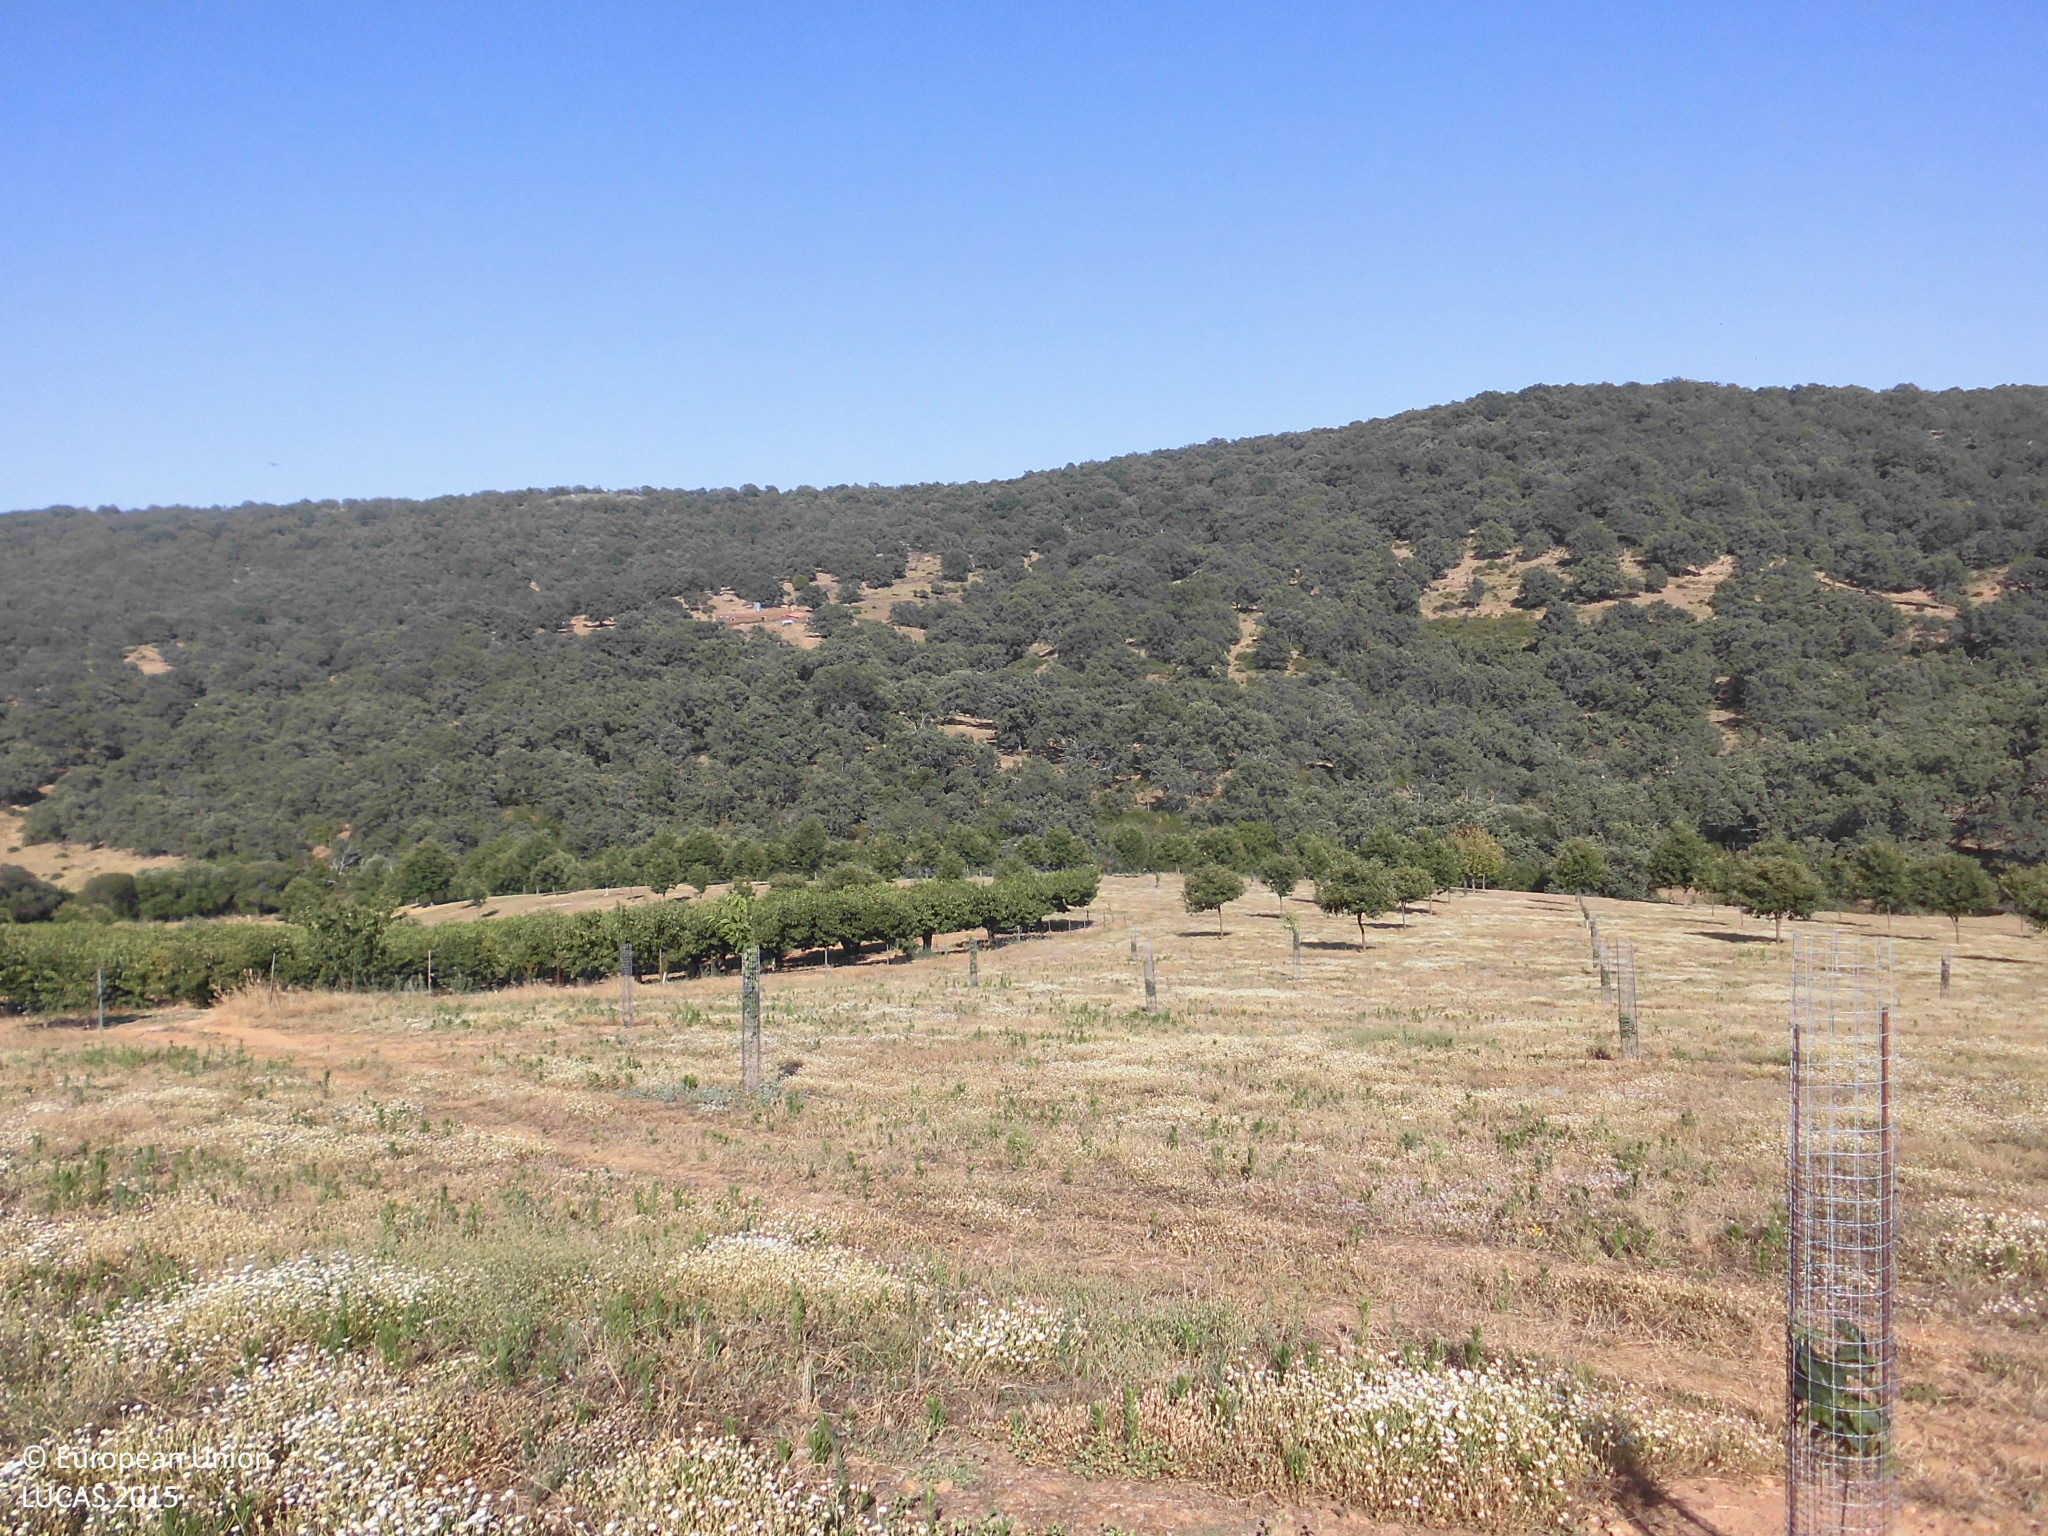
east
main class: Cropland
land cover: Nuts trees
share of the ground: < 10 %
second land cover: Grassland without tree/shrub cover
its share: > 75 %
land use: Agriculture (excluding fallow land and kitchen gardens)
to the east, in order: Nuts trees; Grassland without tree/shrub cover; Nuts trees; Fences; Cherry fruit; Fences; Nuts trees; Fences; Grassland with sparse tree/shrub cover
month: July
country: ES
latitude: 39.4044
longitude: -5.5548
